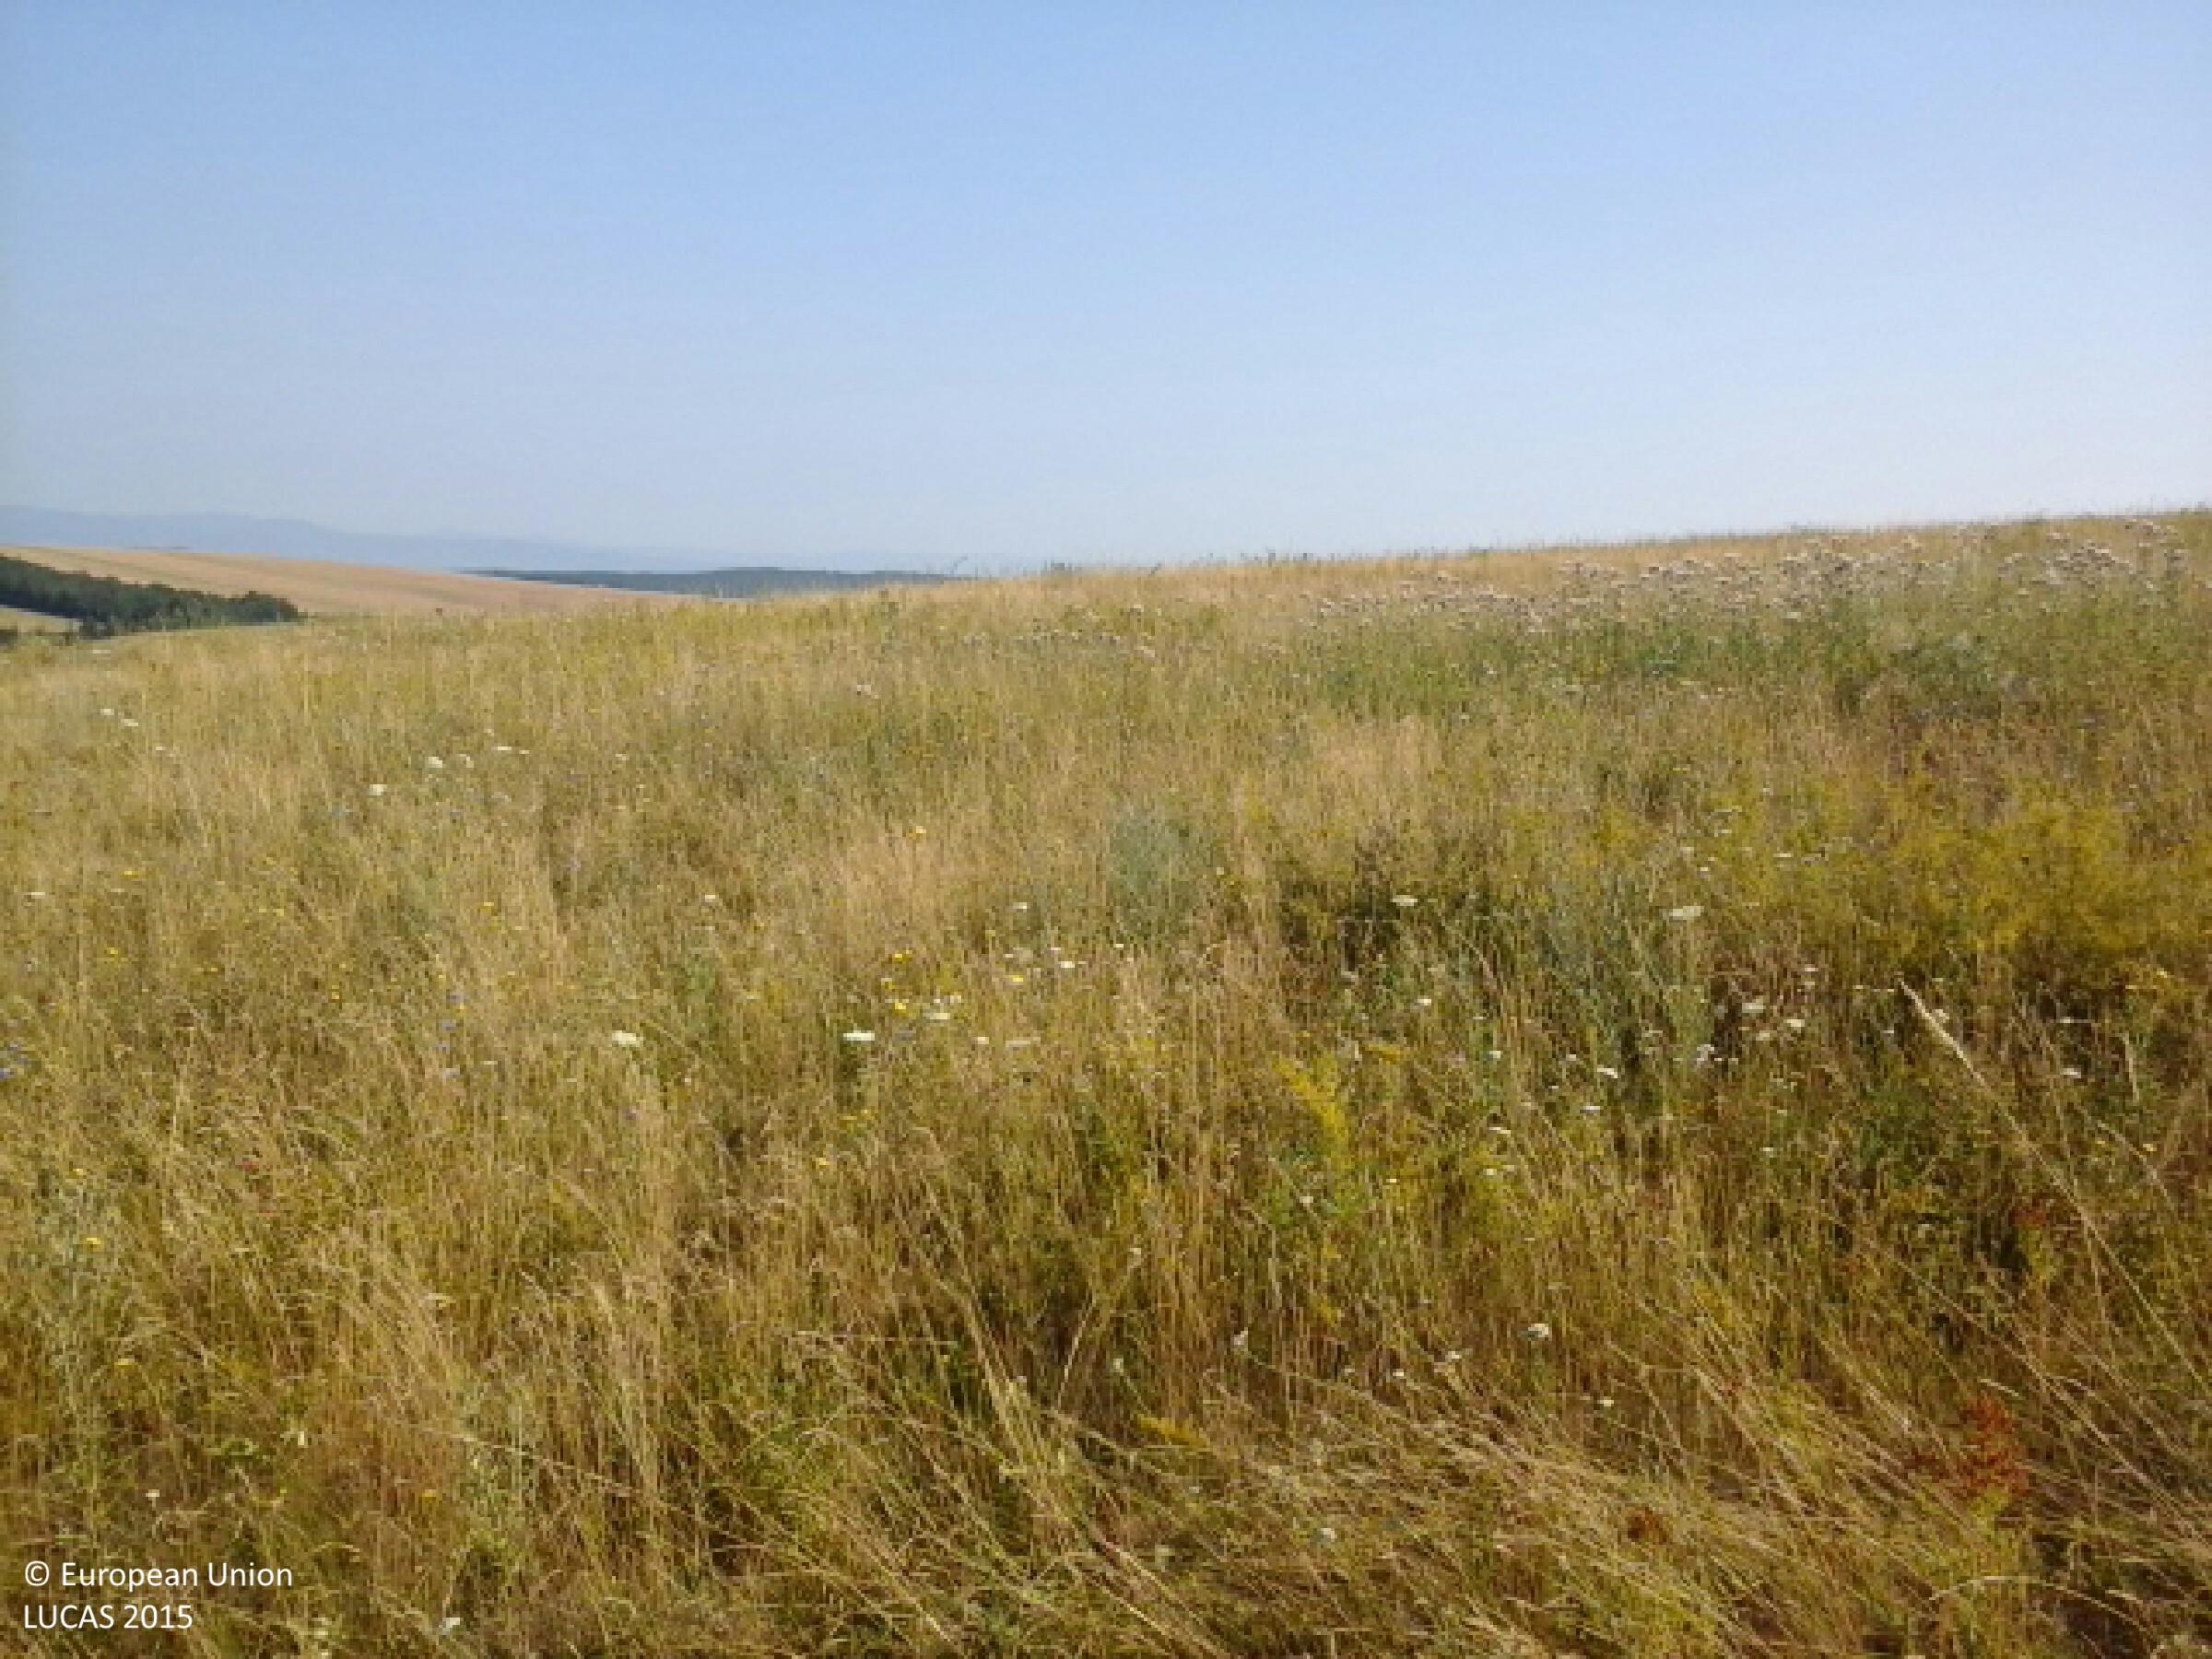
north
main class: Grassland
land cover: Spontaneously vegetated surfaces
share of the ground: > 75 %
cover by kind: herbaceous plants 100 %
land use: Fallow land
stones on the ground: < 10 %
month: July
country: HU
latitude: 48.4186
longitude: 20.9713
